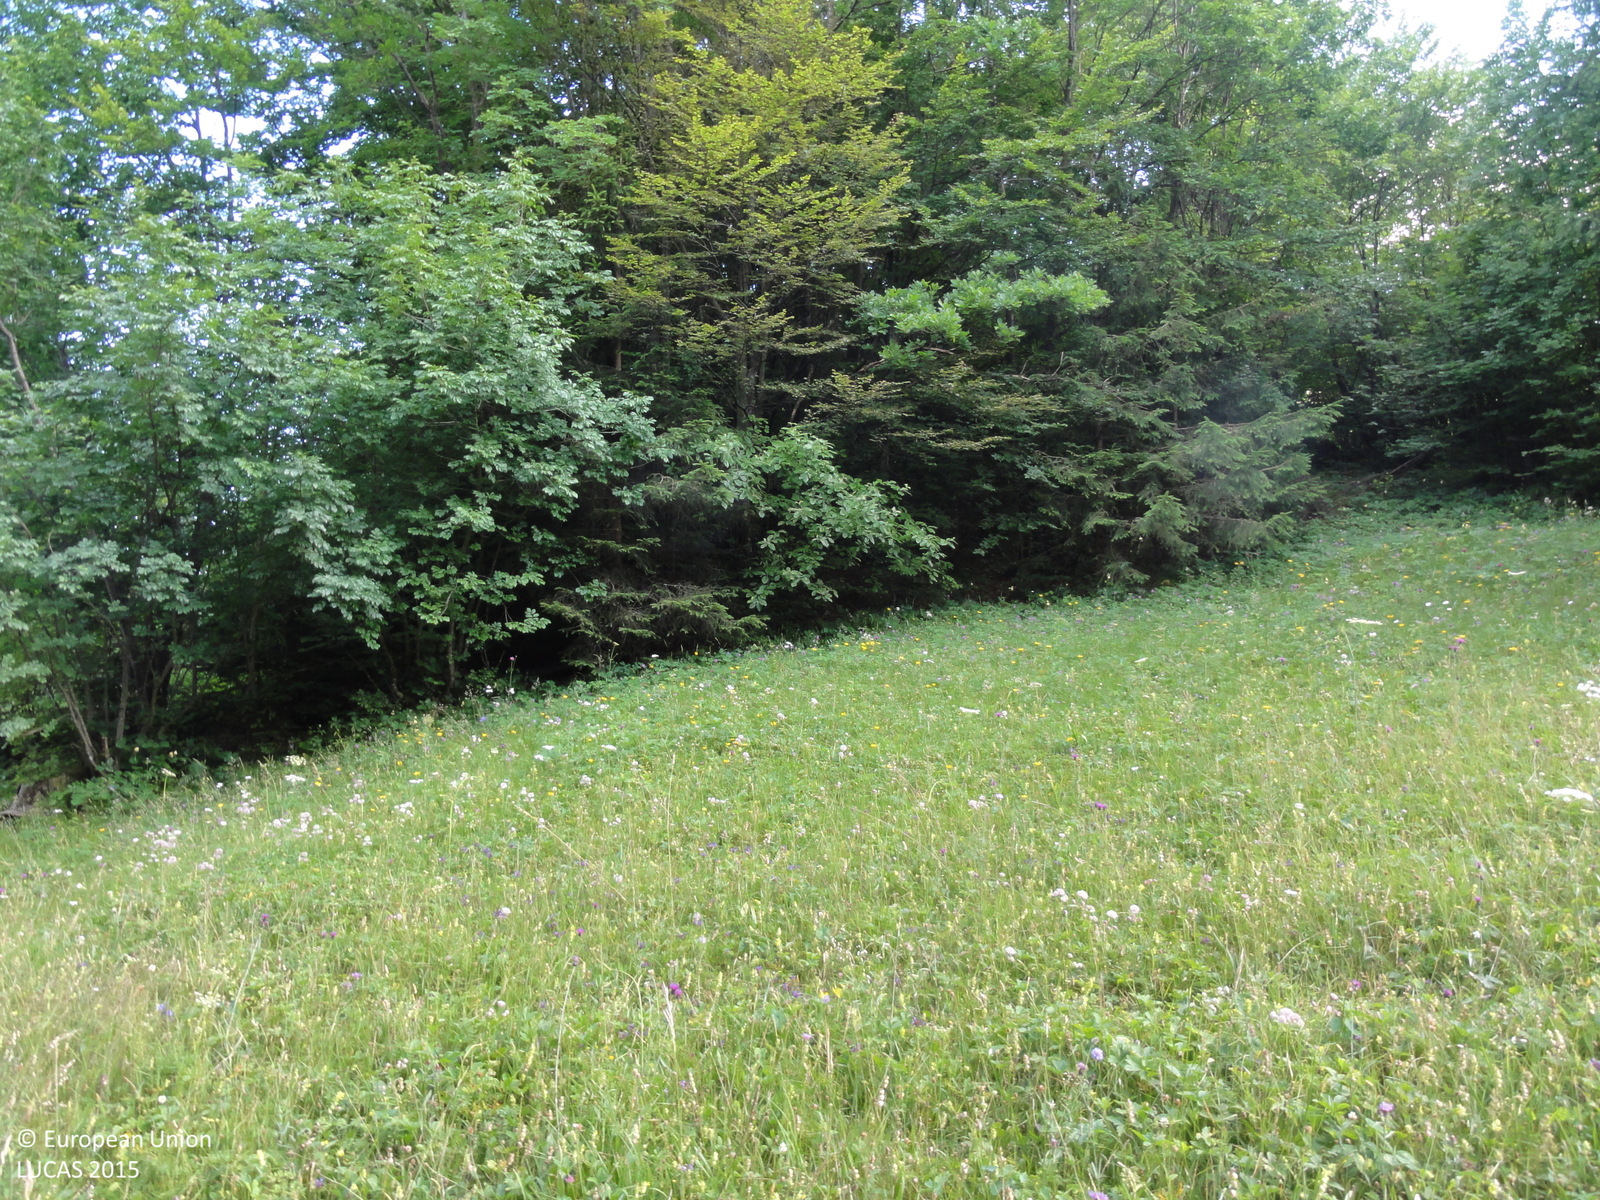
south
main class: Grassland
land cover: Grassland without tree/shrub cover
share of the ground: > 75 %
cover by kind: herbaceous plants 100 %
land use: Agriculture (excluding fallow land and kitchen gardens)
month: June
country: SI
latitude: 46.3661
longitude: 15.2623
